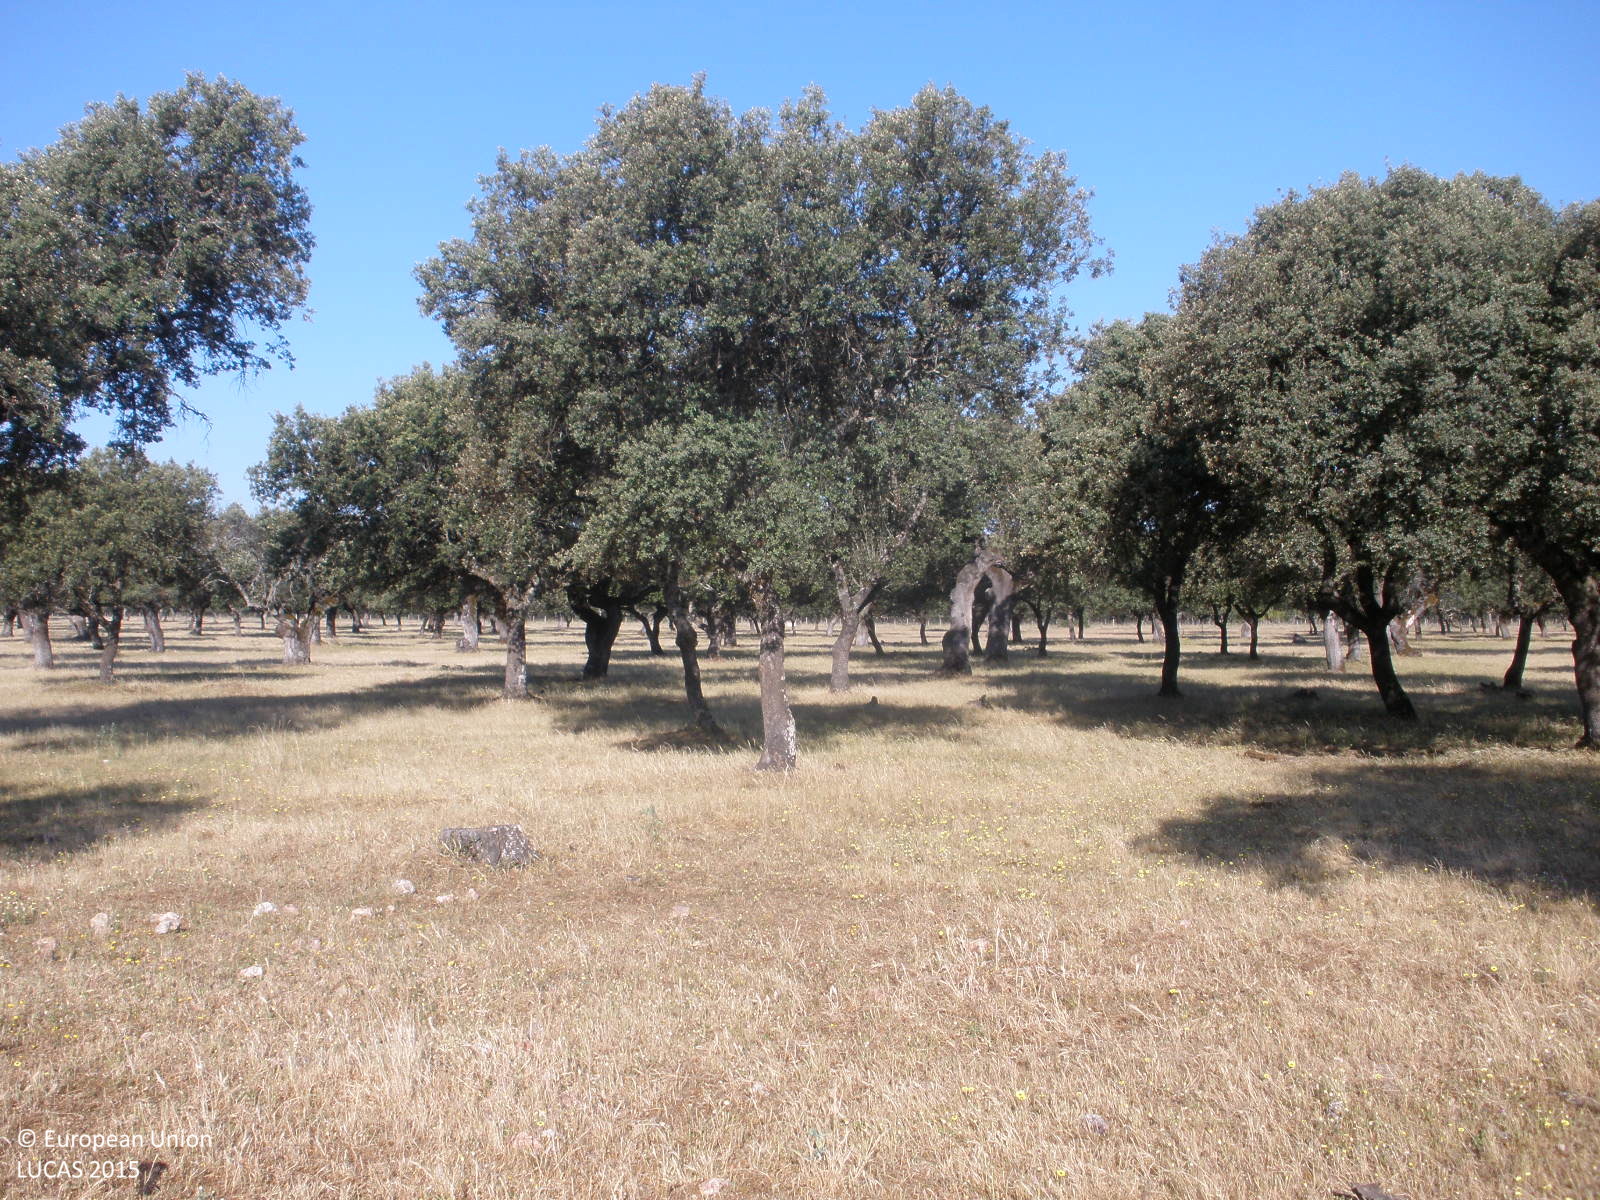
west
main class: Woodland
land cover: Broadleaved woodland
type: broadleaved evergreen forest
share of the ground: 25 - 50 %
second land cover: Grassland without tree/shrub cover
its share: > 75 %
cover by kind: herbaceous plants 70 %, broadleaved forest trees 30 %
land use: Forestry
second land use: Agriculture (excluding fallow land and kitchen gardens)
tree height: > 5 m
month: May
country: ES
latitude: 40.1685
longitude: -6.0541
